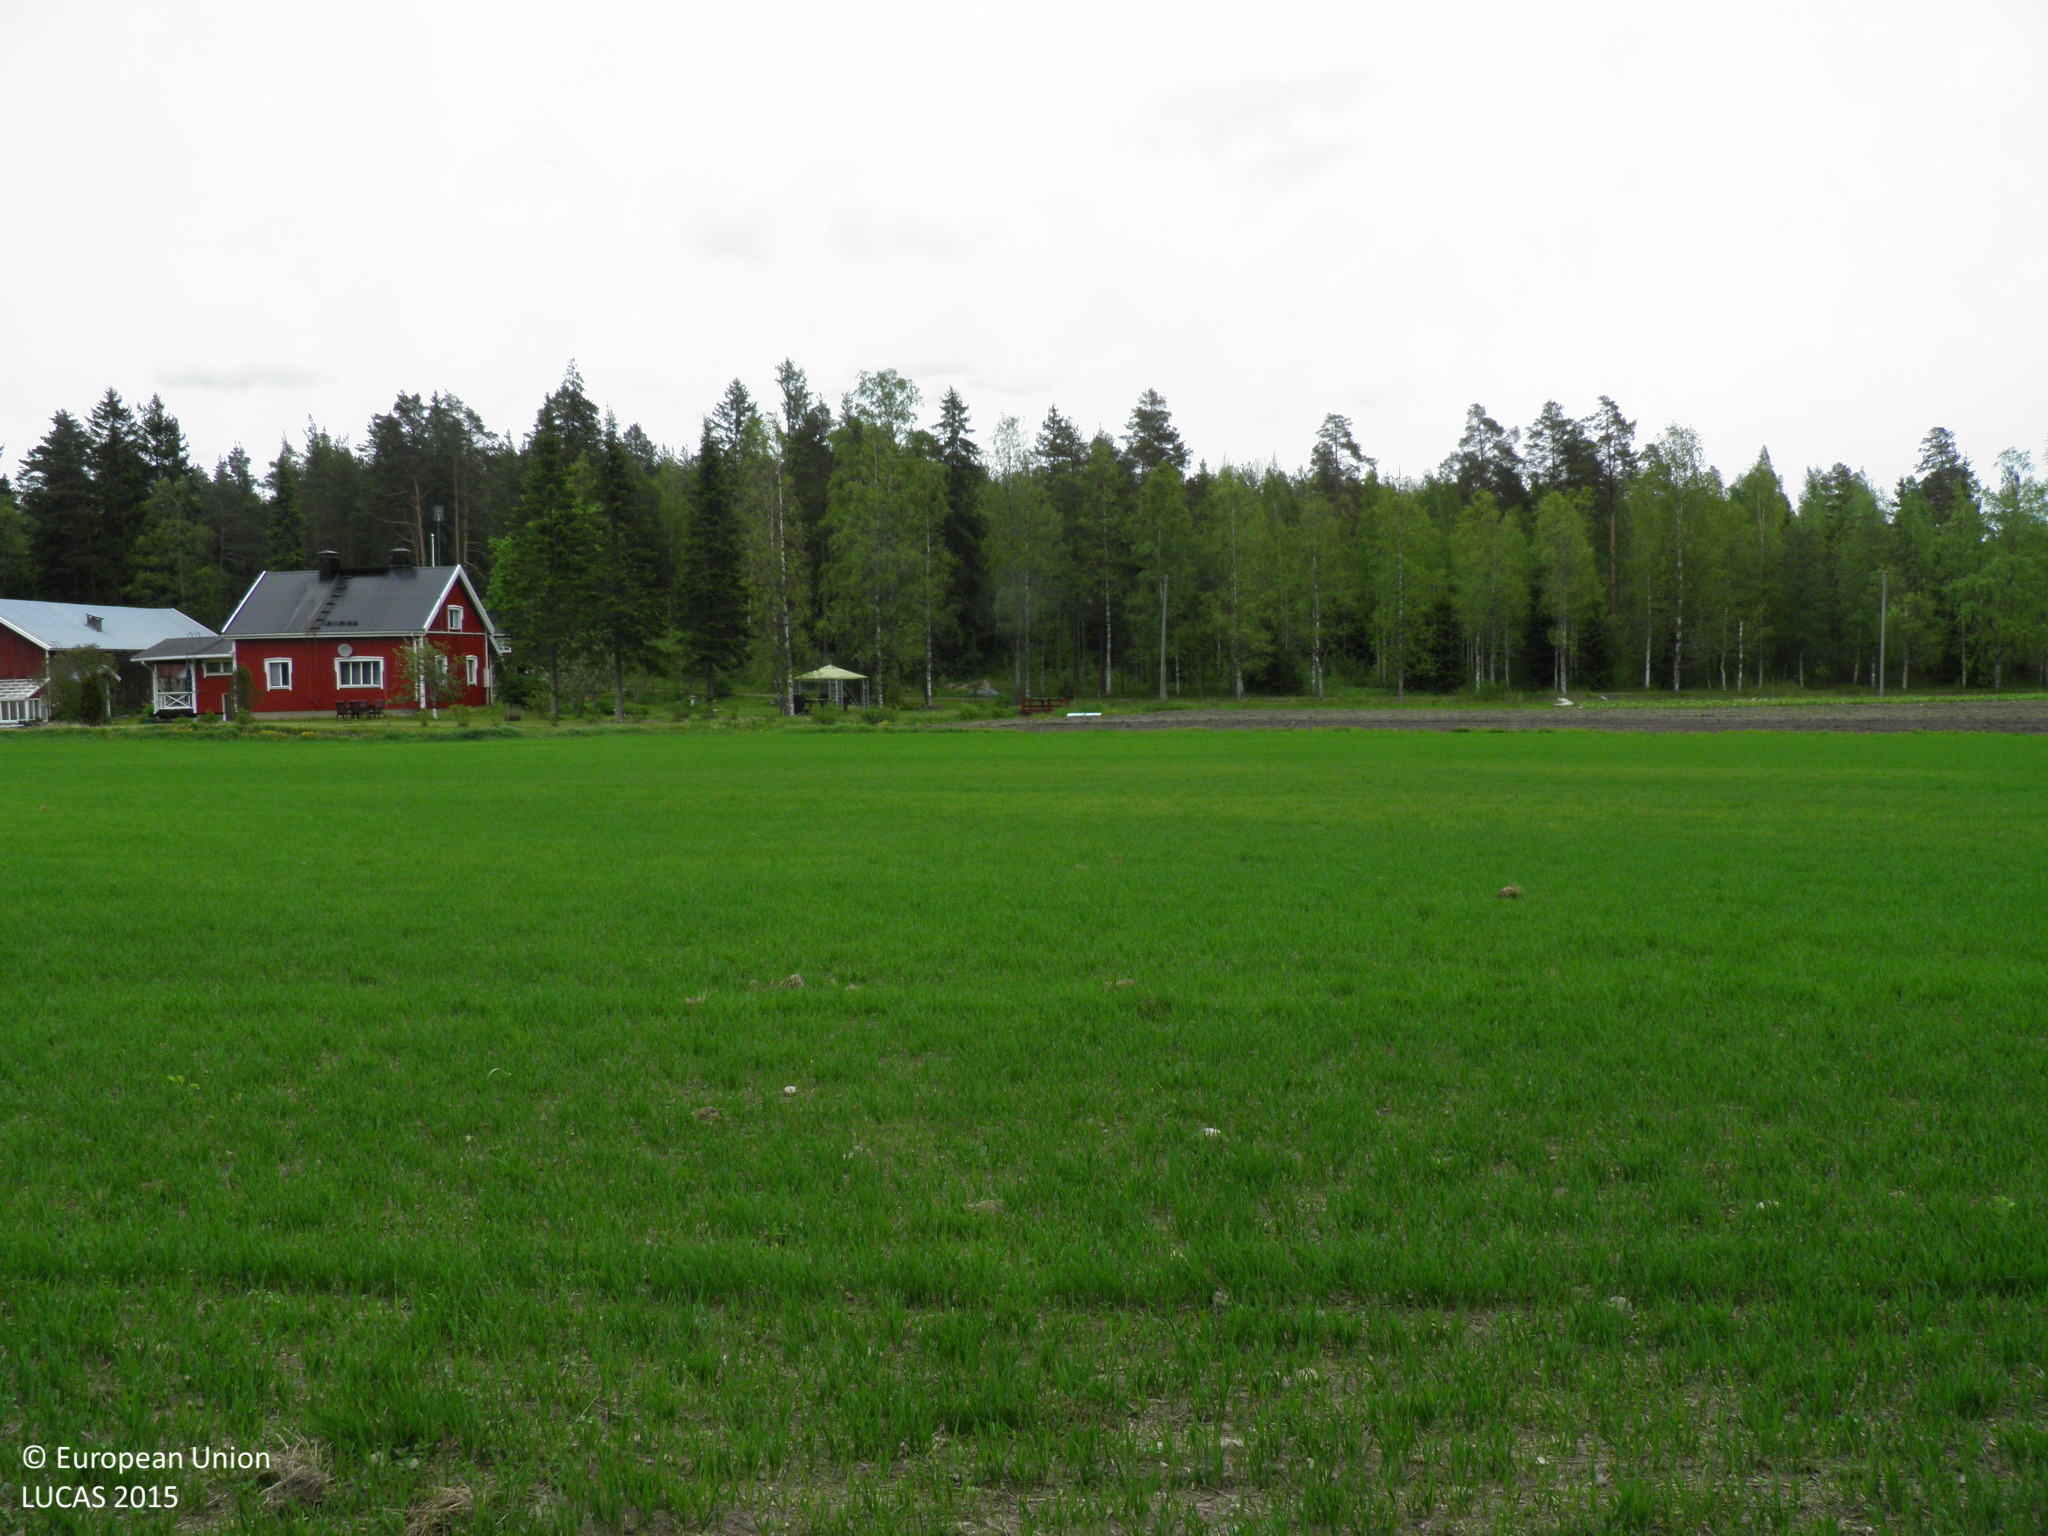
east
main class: Cropland
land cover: Oats
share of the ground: 50 - 75 %
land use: Agriculture (excluding fallow land and kitchen gardens)
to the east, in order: Oats; Strawberries; Ditches and canals; Lines of trees; Tracks; Ditches and canals; Lines of trees; Pine dominated mixed woodland; Inland fresh water bodies; Pine dominated mixed woodland; Tracks; Pine dominated mixed woodland; Tracks; Pine dominated mixed woodland
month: June
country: FI
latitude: 60.5031
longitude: 22.6538
